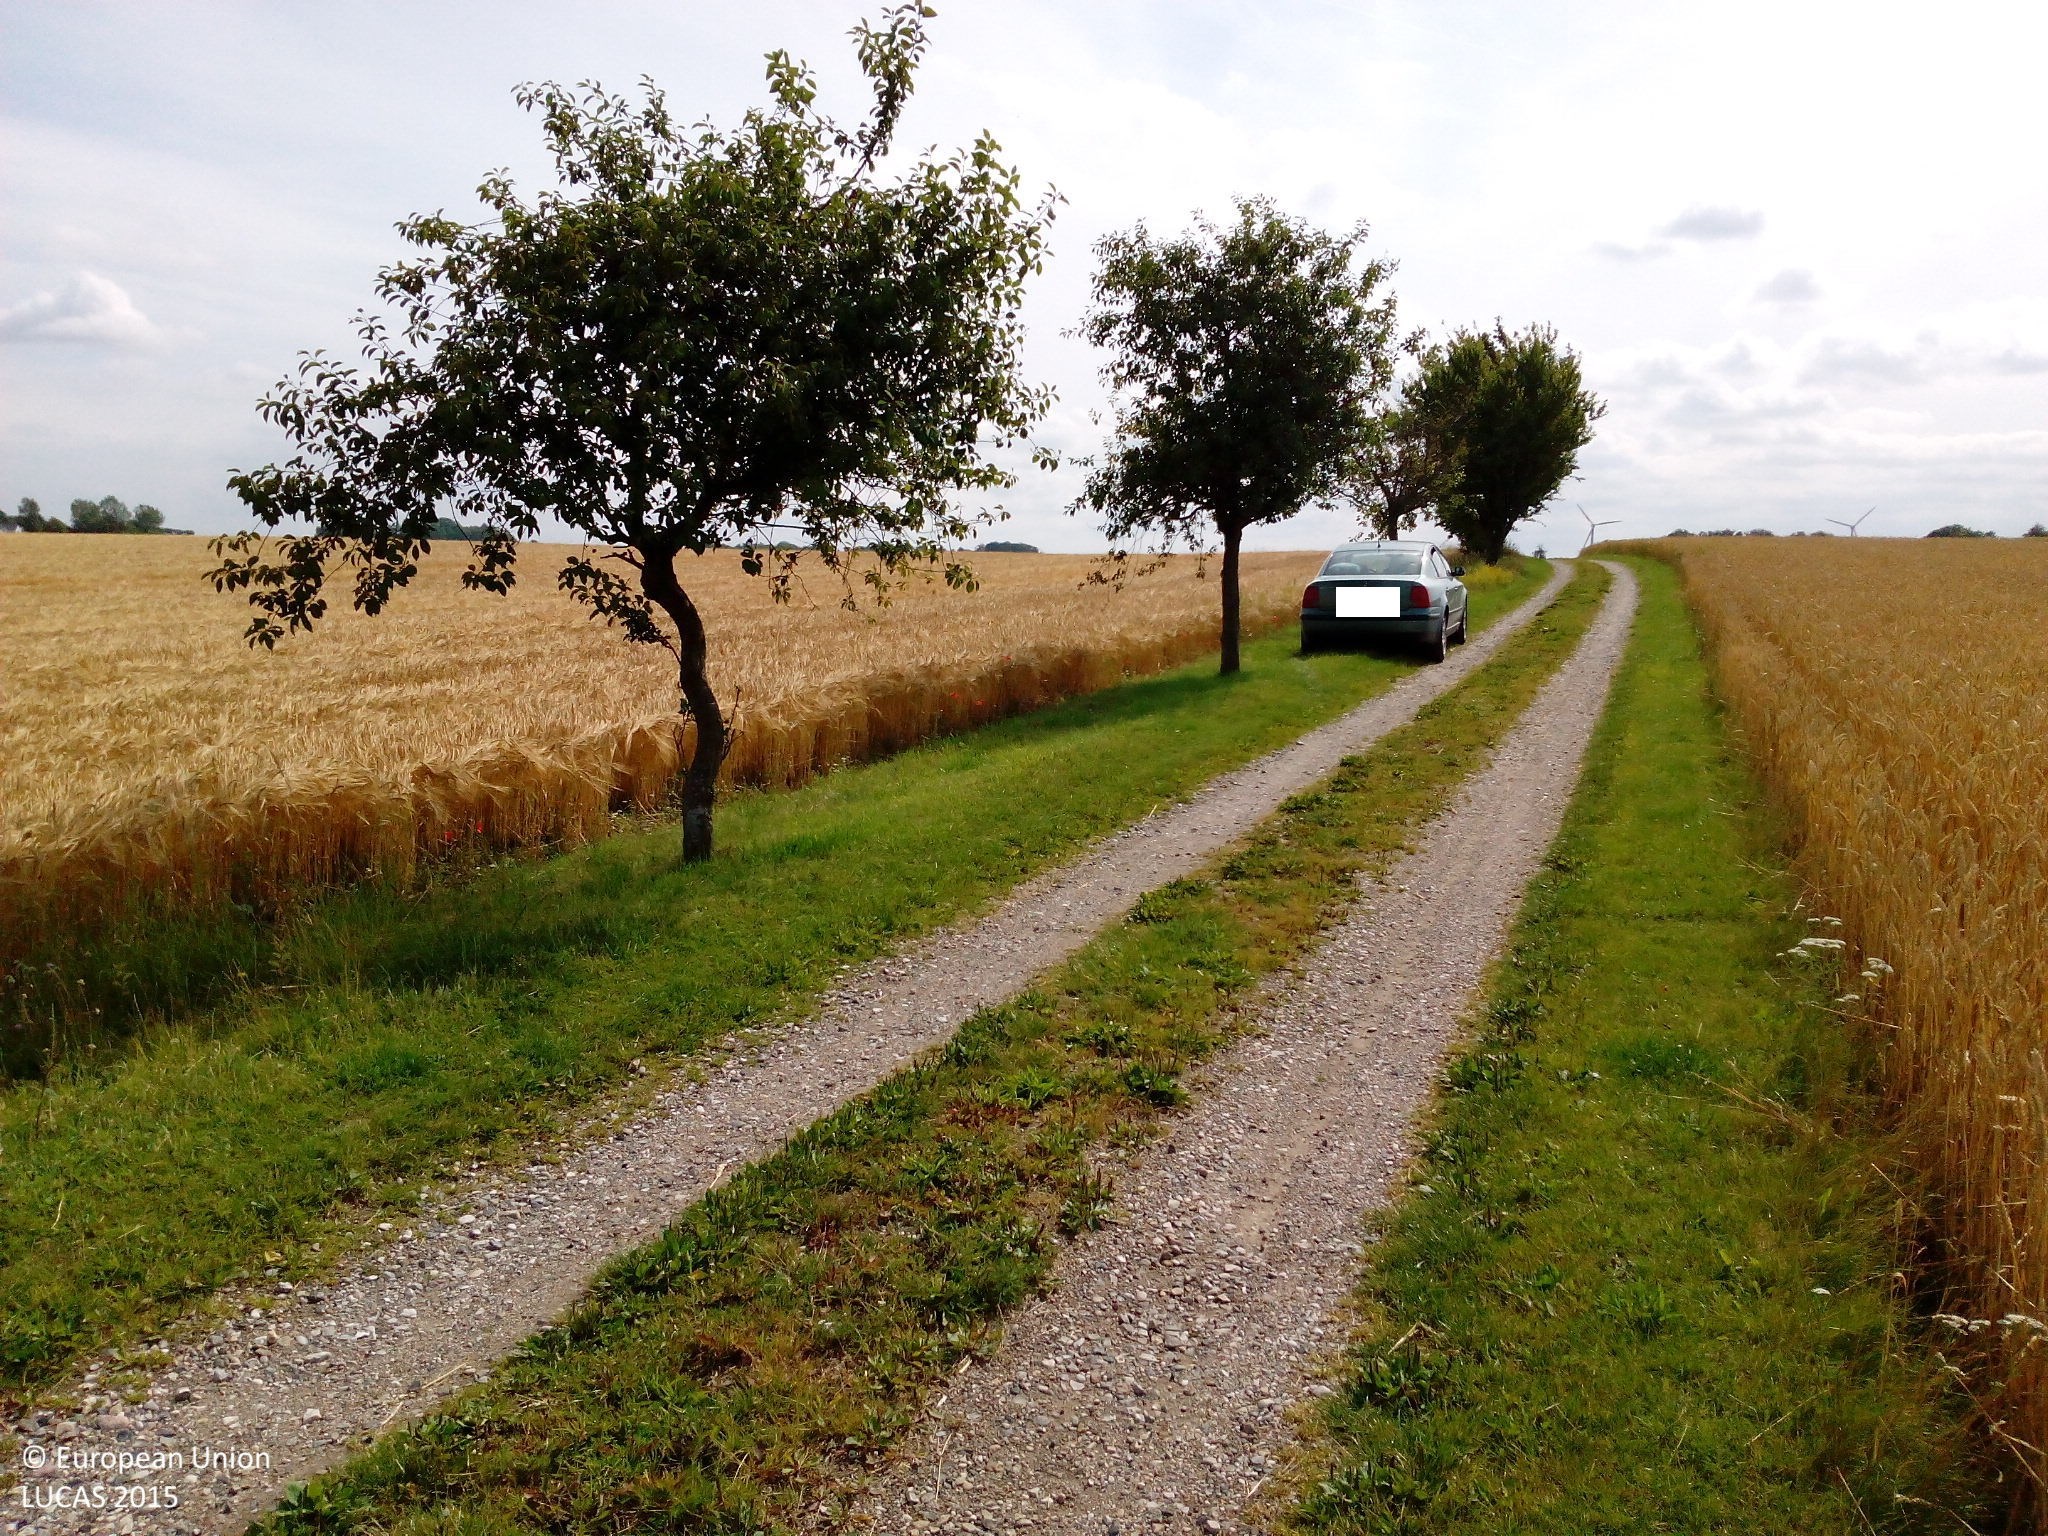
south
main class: Cropland
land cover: Common wheat
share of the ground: > 75 %
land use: Agriculture (excluding fallow land and kitchen gardens)
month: August
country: DK
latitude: 55.5596
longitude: 12.0753
